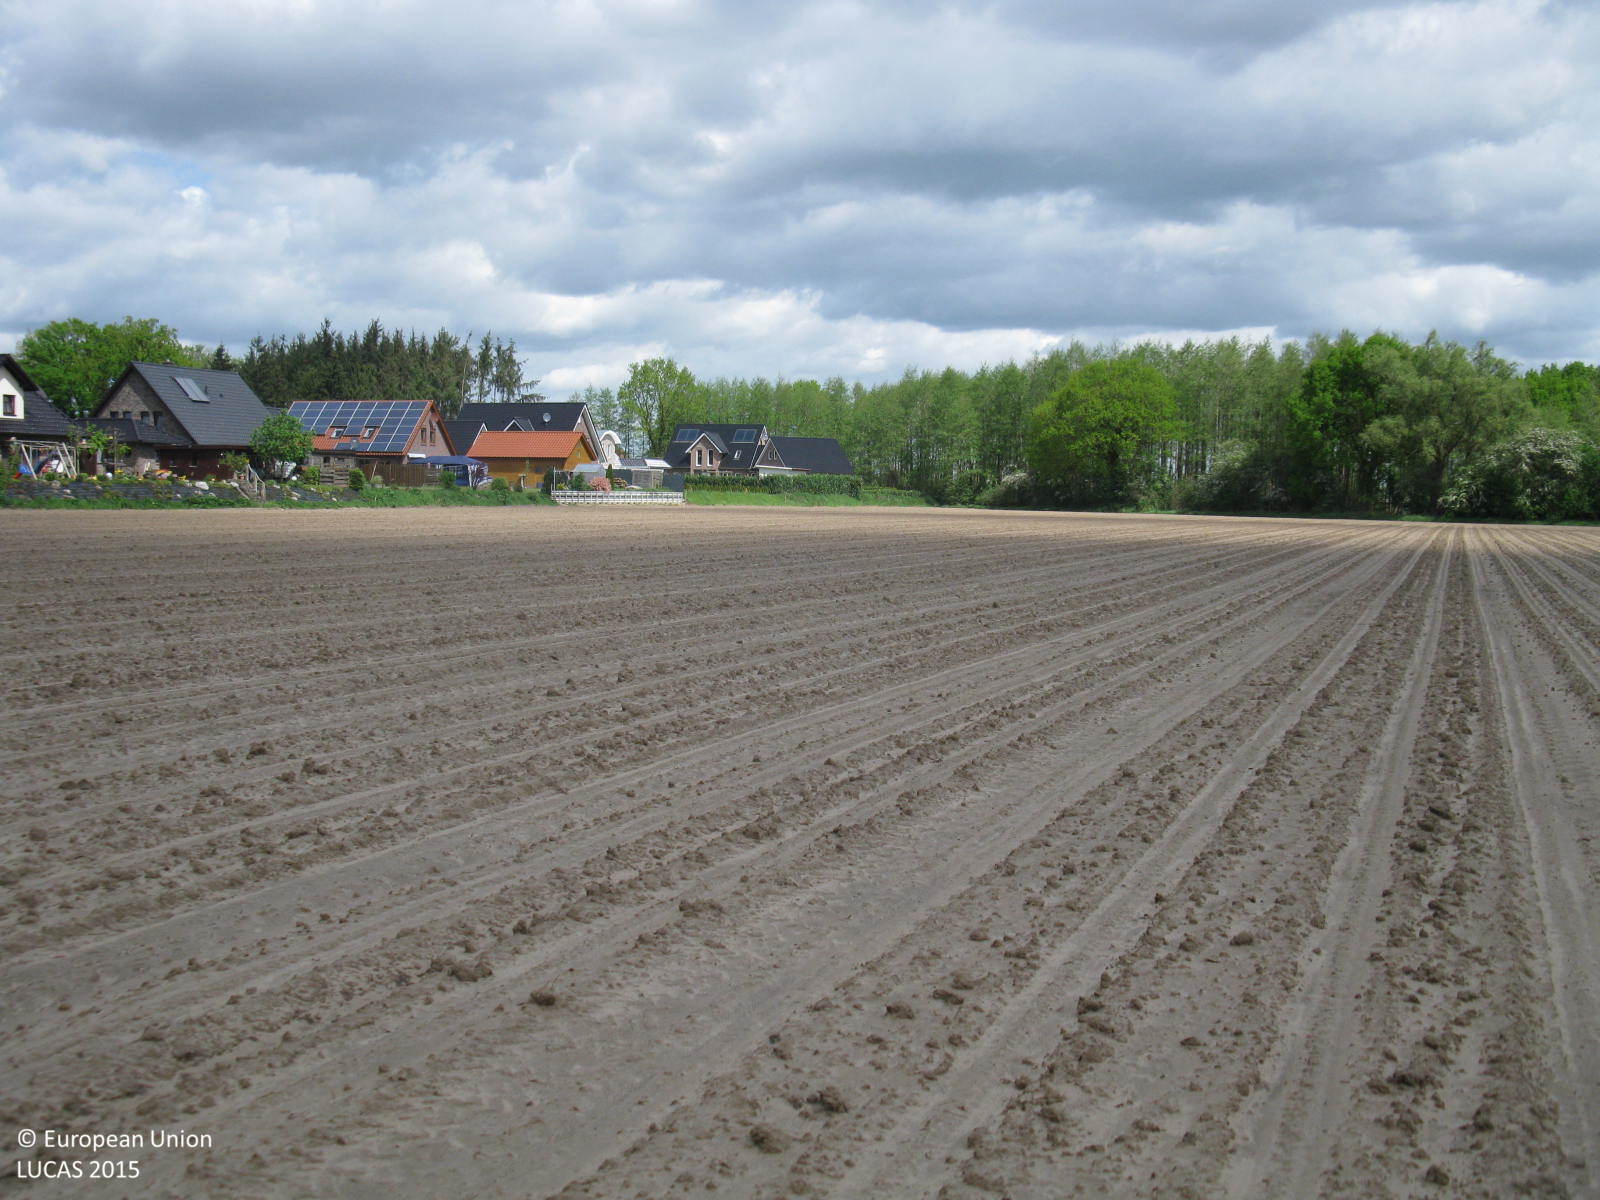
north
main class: Cropland
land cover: Maize
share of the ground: < 10 %
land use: Agriculture (excluding fallow land and kitchen gardens)
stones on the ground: < 10 %
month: May
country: DE
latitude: 52.9225
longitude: 7.3083
